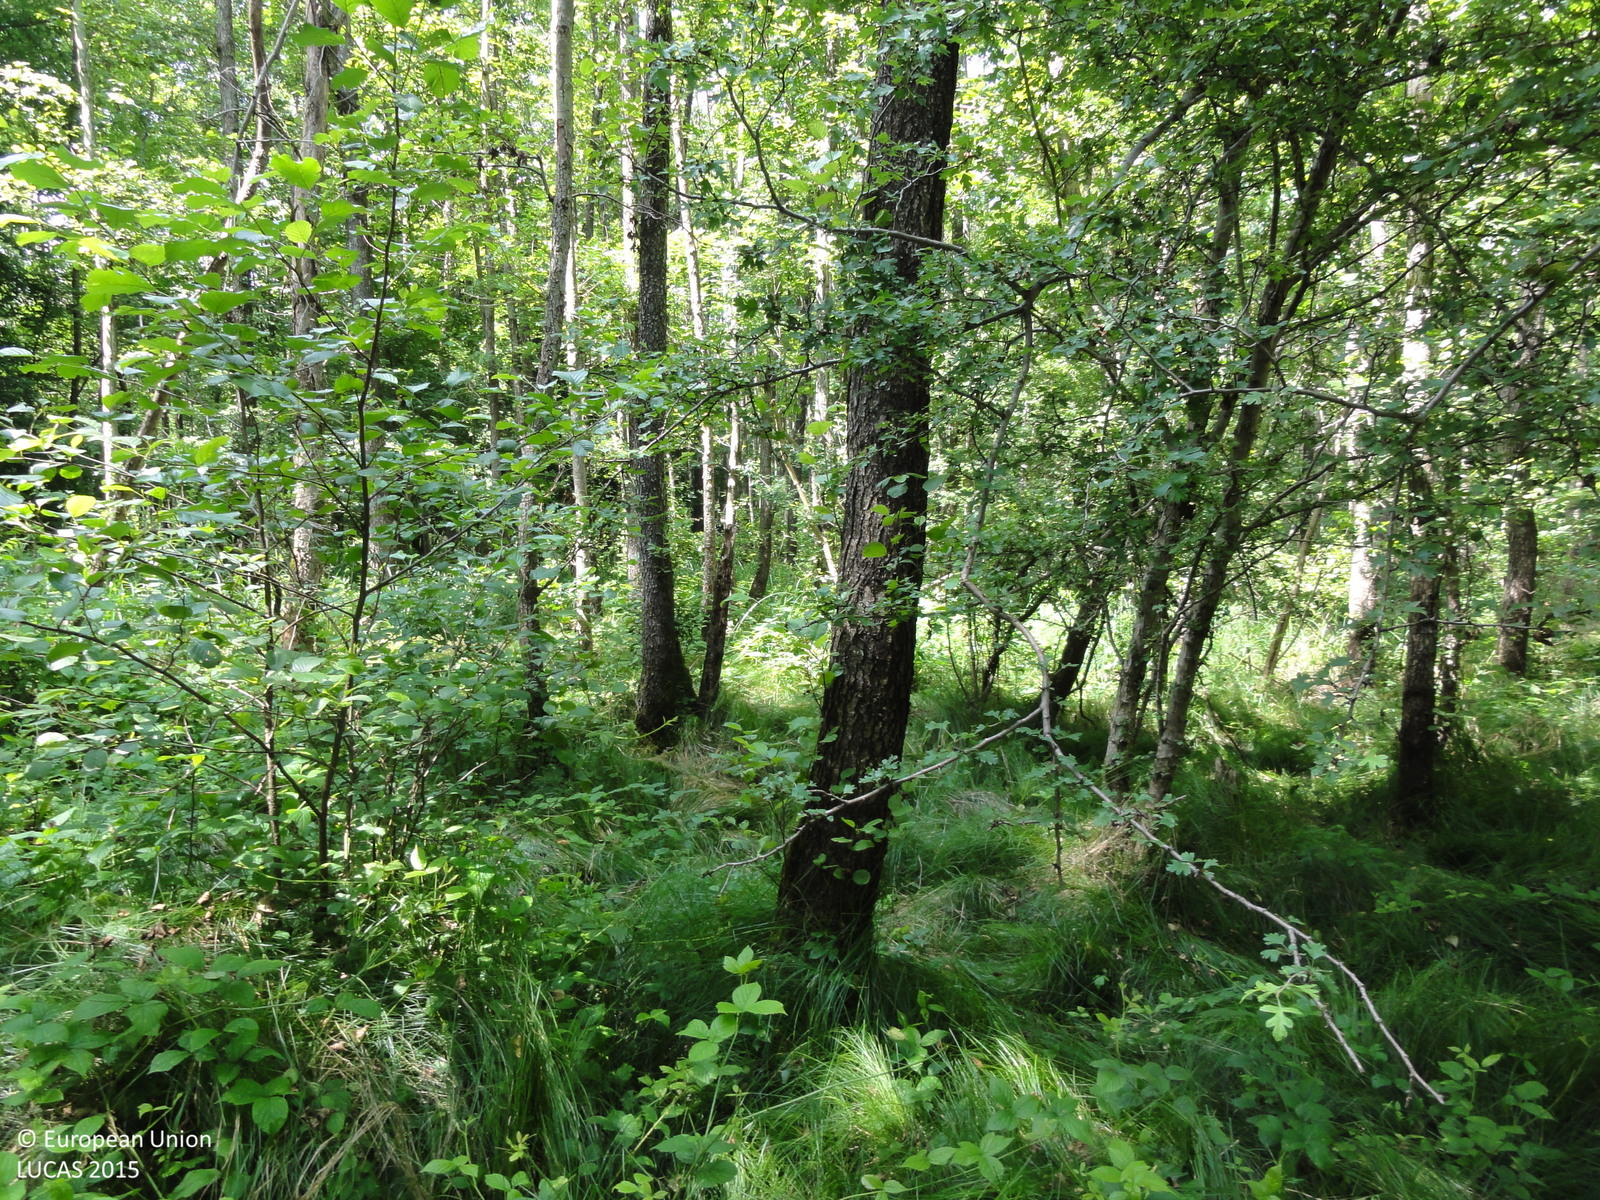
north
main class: Woodland
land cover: Broadleaved woodland
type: non-riverine alder, birch or aspen forest
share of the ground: > 75 %
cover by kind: broadleaved forest trees 95 %, herbaceous plants 5 %
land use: Forestry
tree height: > 5 m
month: June
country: SI
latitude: 46.5925
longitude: 16.4098
